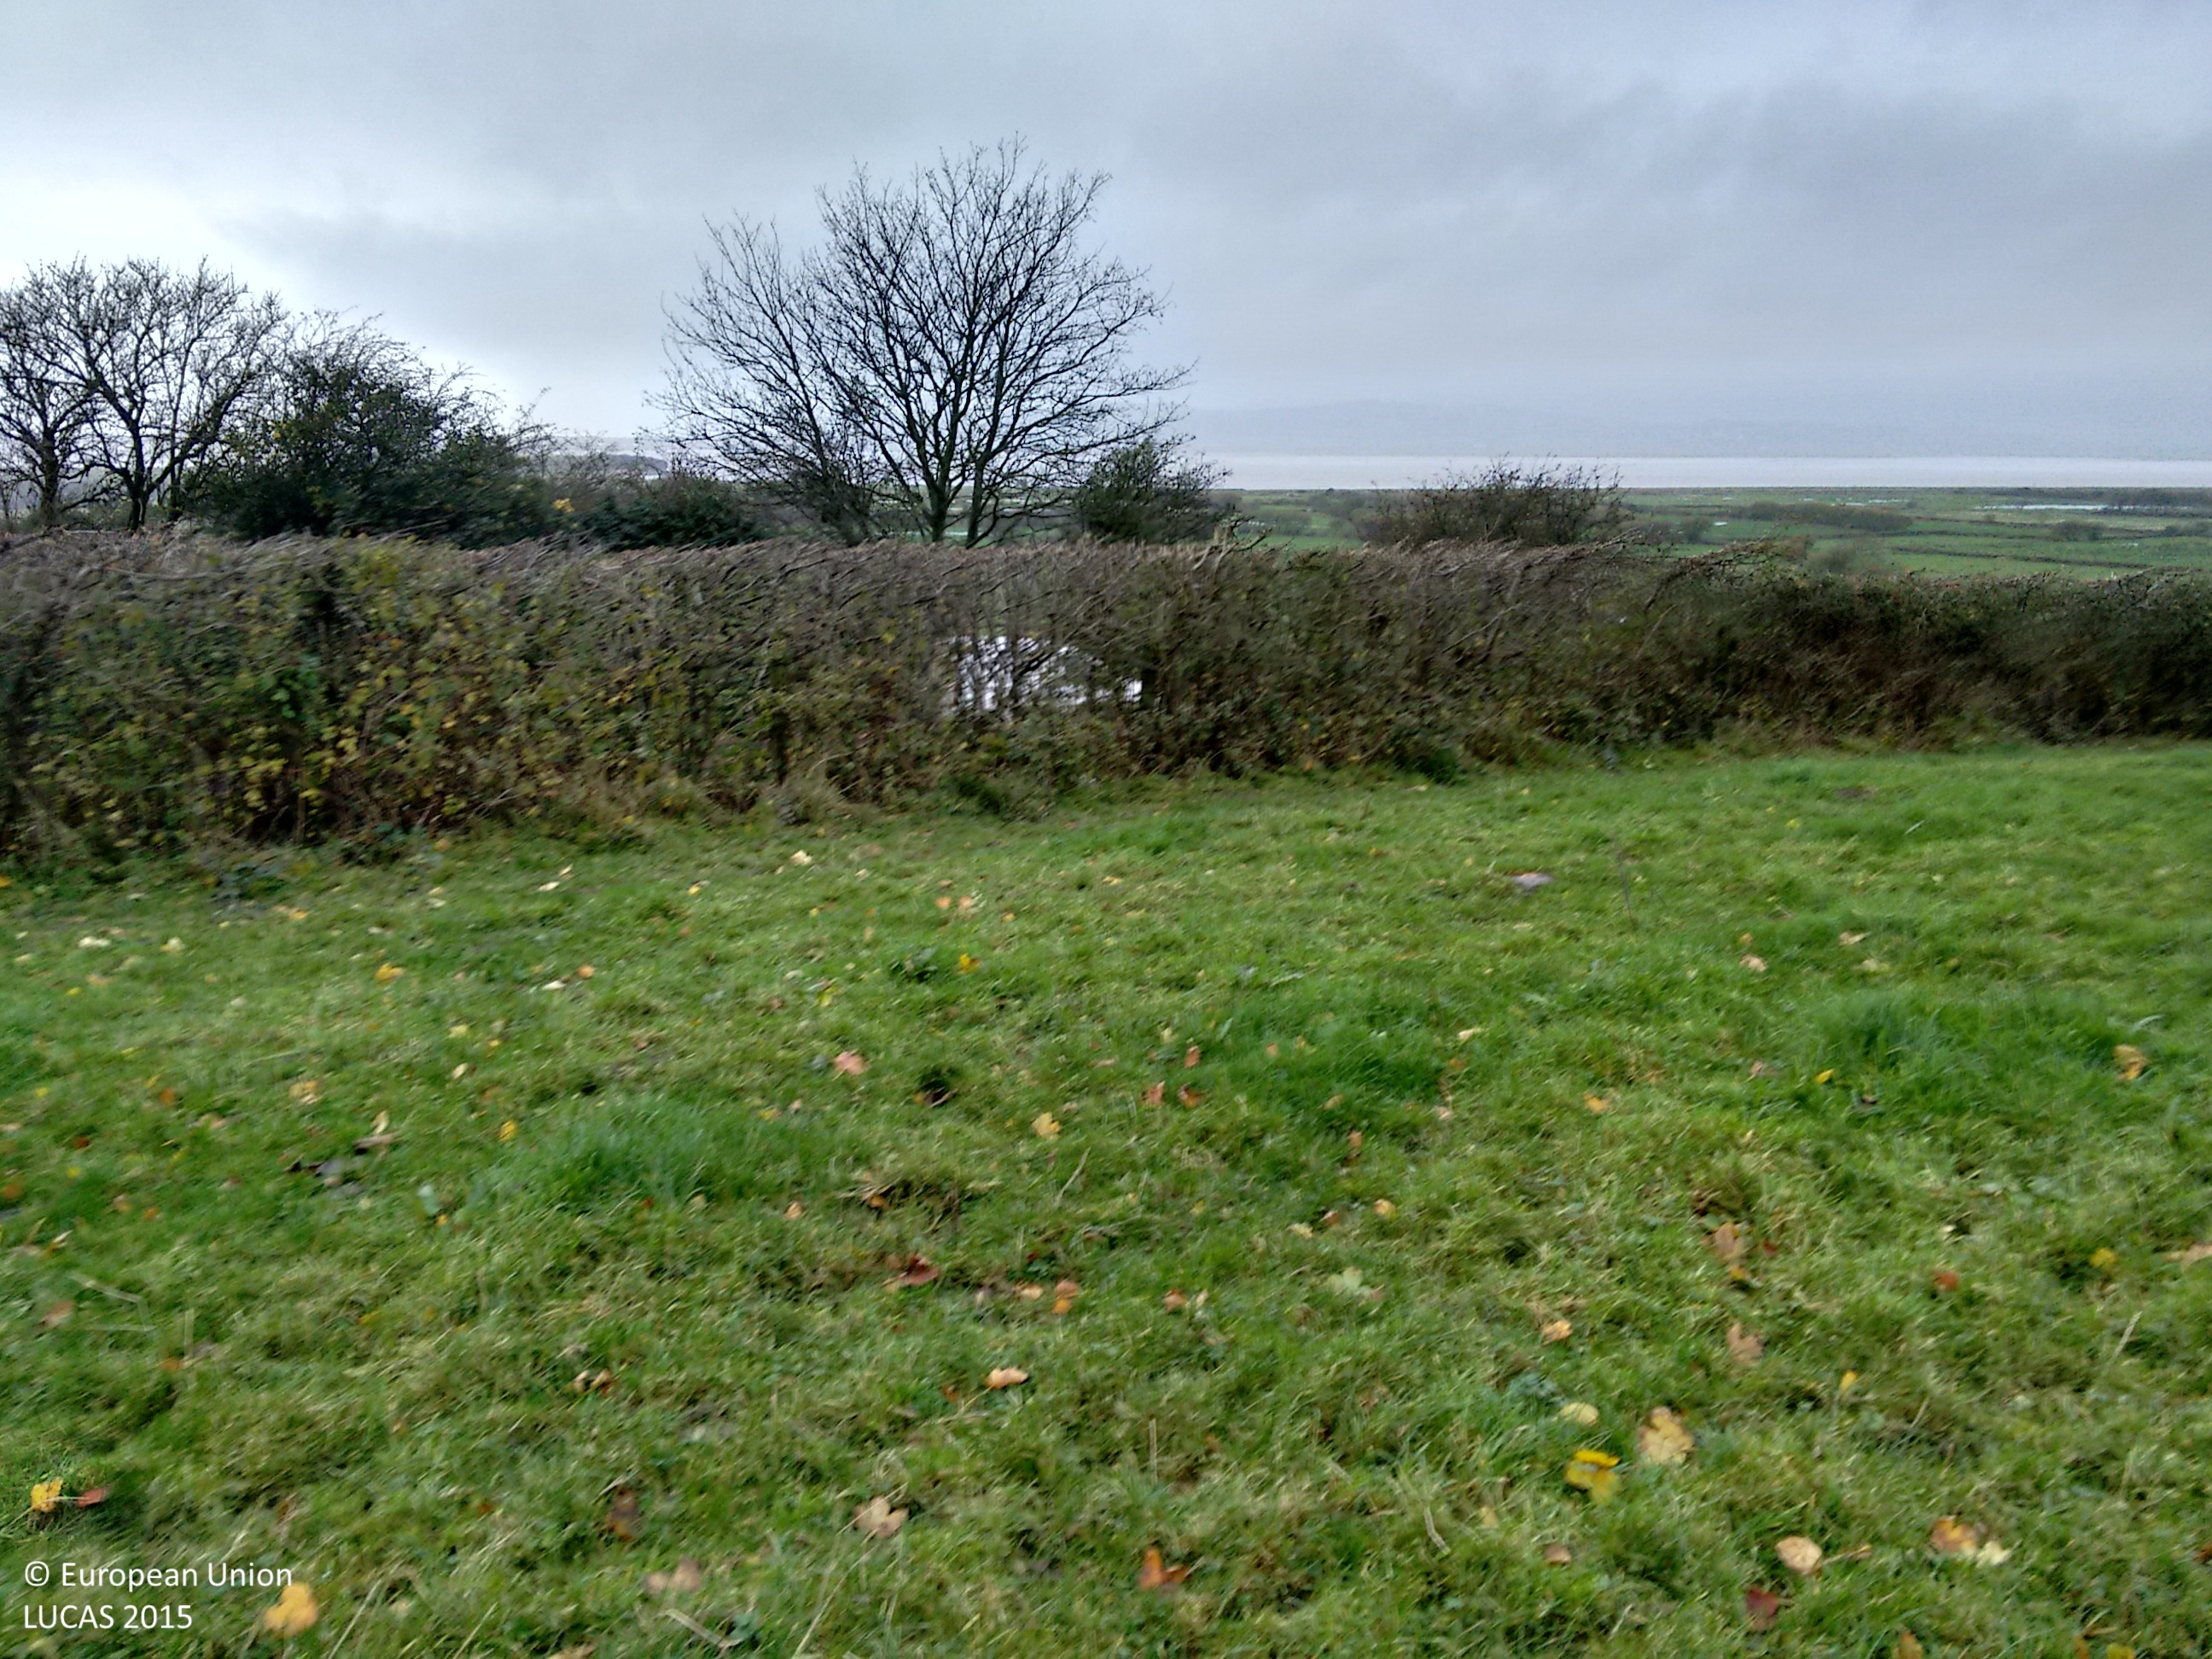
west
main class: Grassland
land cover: Grassland without tree/shrub cover
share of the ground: > 75 %
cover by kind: herbaceous plants 100 %
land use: Agriculture (excluding fallow land and kitchen gardens)
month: November
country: GB
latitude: 54.2083
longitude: -3.1856
